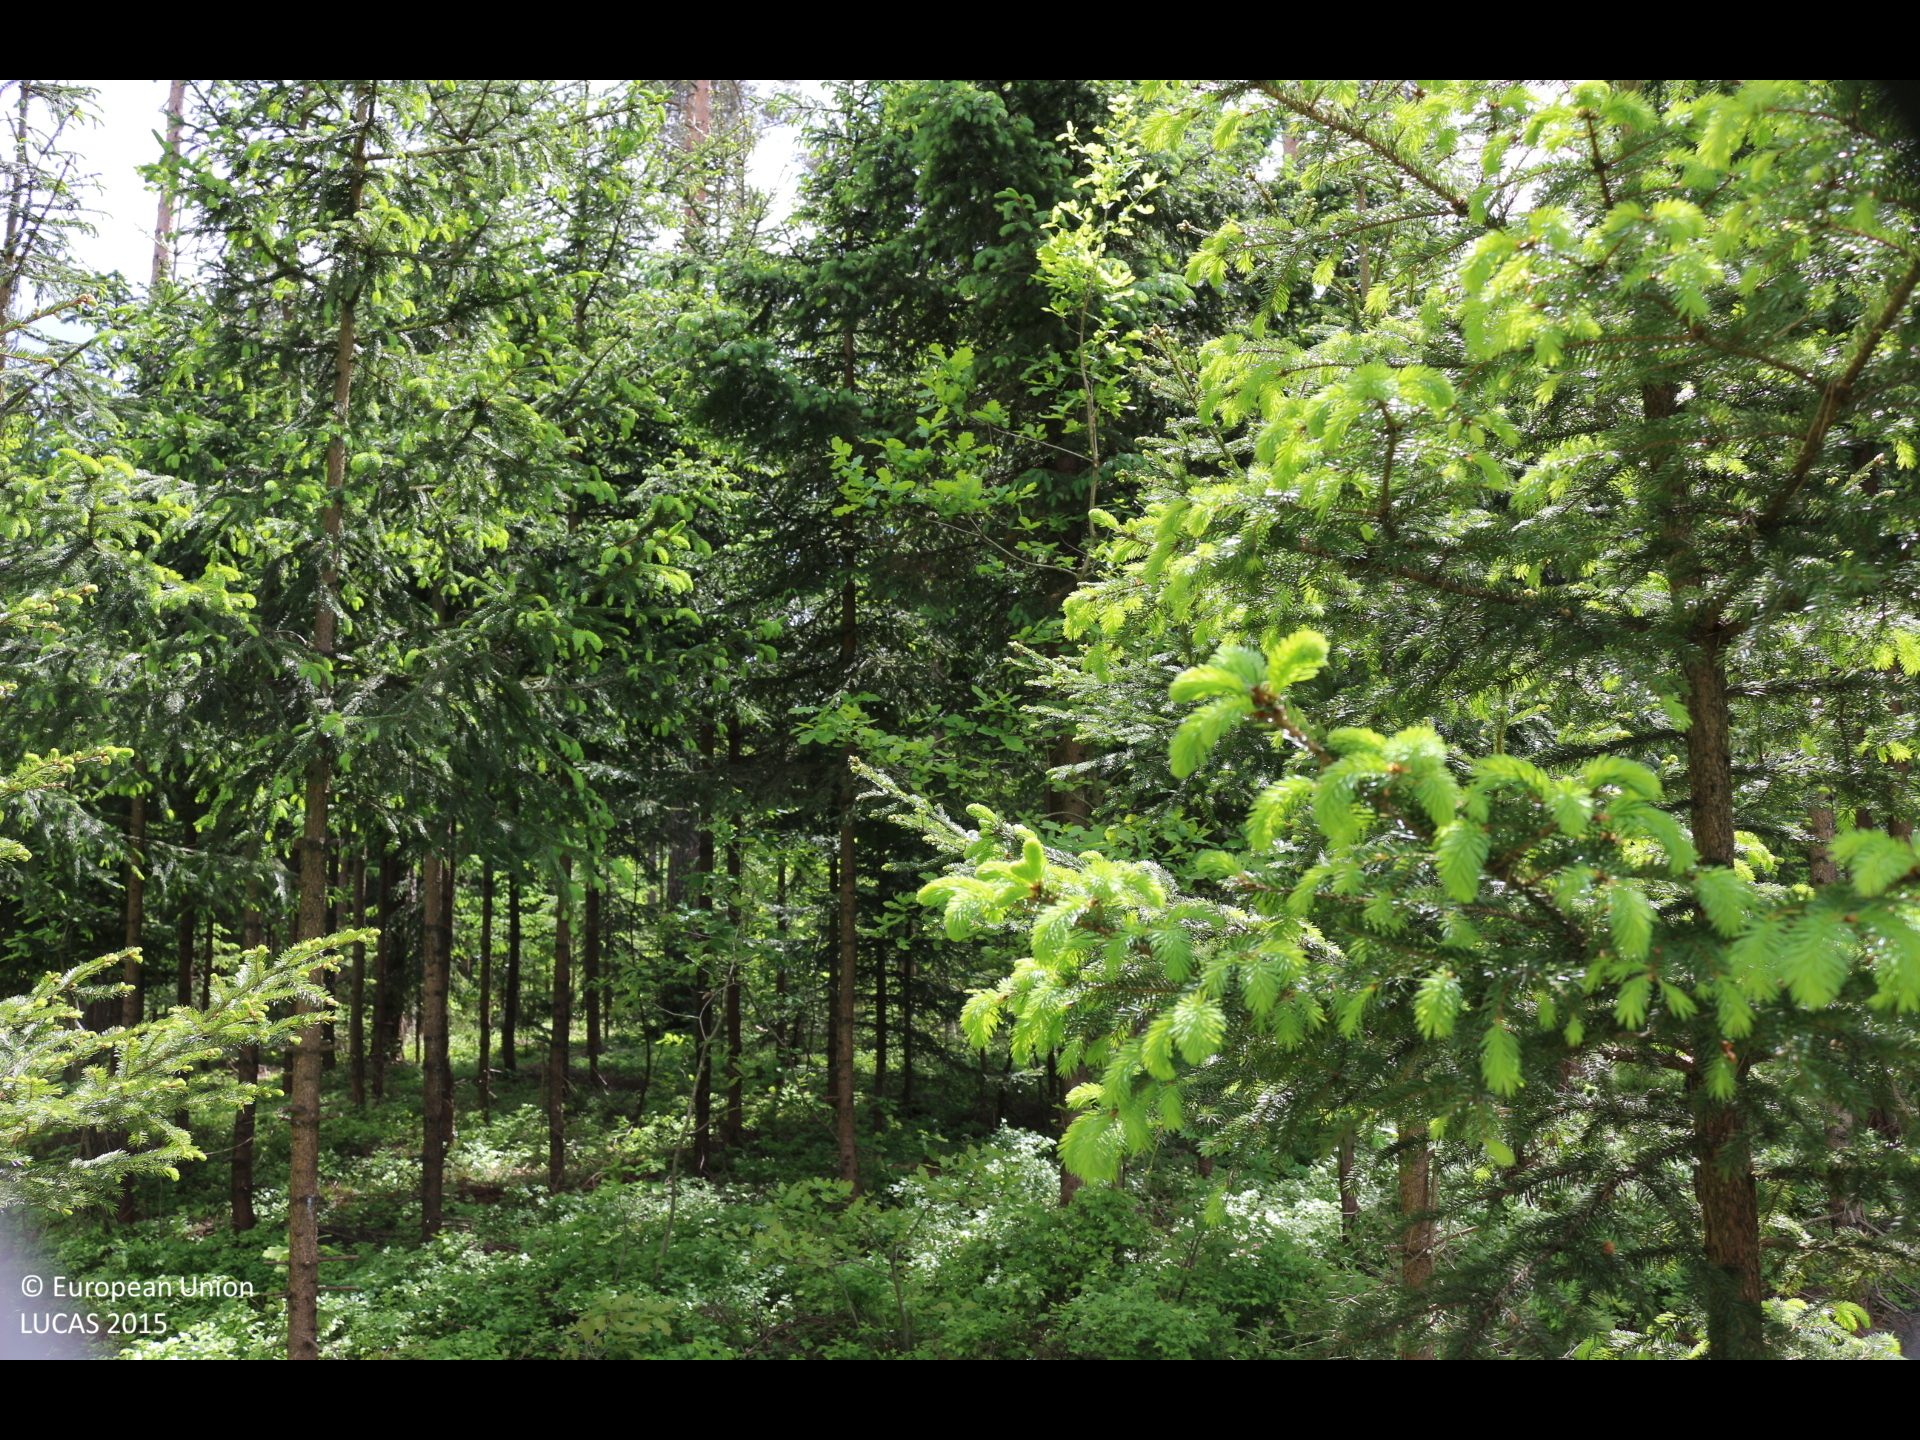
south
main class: Woodland
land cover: Other coniferous woodland
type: alpine coniferous forest
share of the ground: > 75 %
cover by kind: coniferous forest trees 90 %, shrubs 10 %
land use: Forestry
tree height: > 5 m
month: May
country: AT
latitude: 46.6373
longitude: 14.4521
